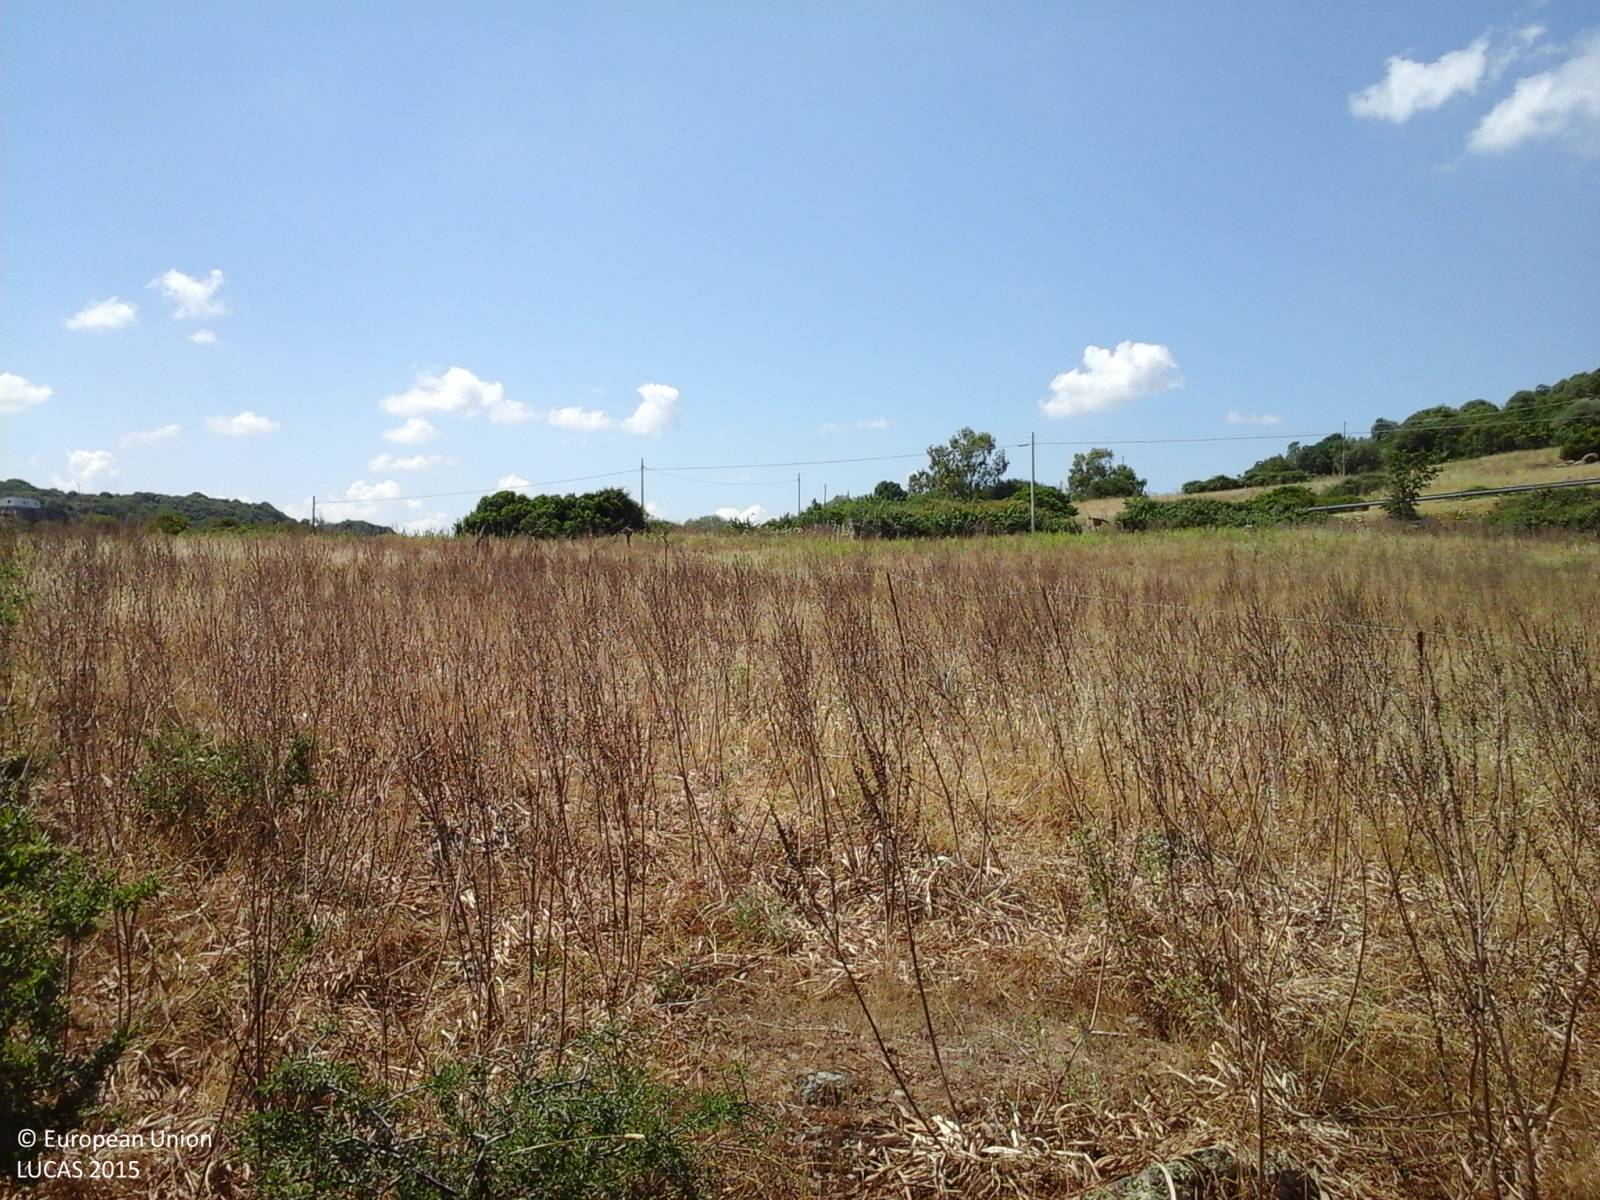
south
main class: Grassland
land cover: Grassland without tree/shrub cover
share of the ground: > 75 %
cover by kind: herbaceous plants 95 %, shrubs 5 %
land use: Agriculture (excluding fallow land and kitchen gardens)
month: June
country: IT
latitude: 40.7494
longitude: 8.8567
